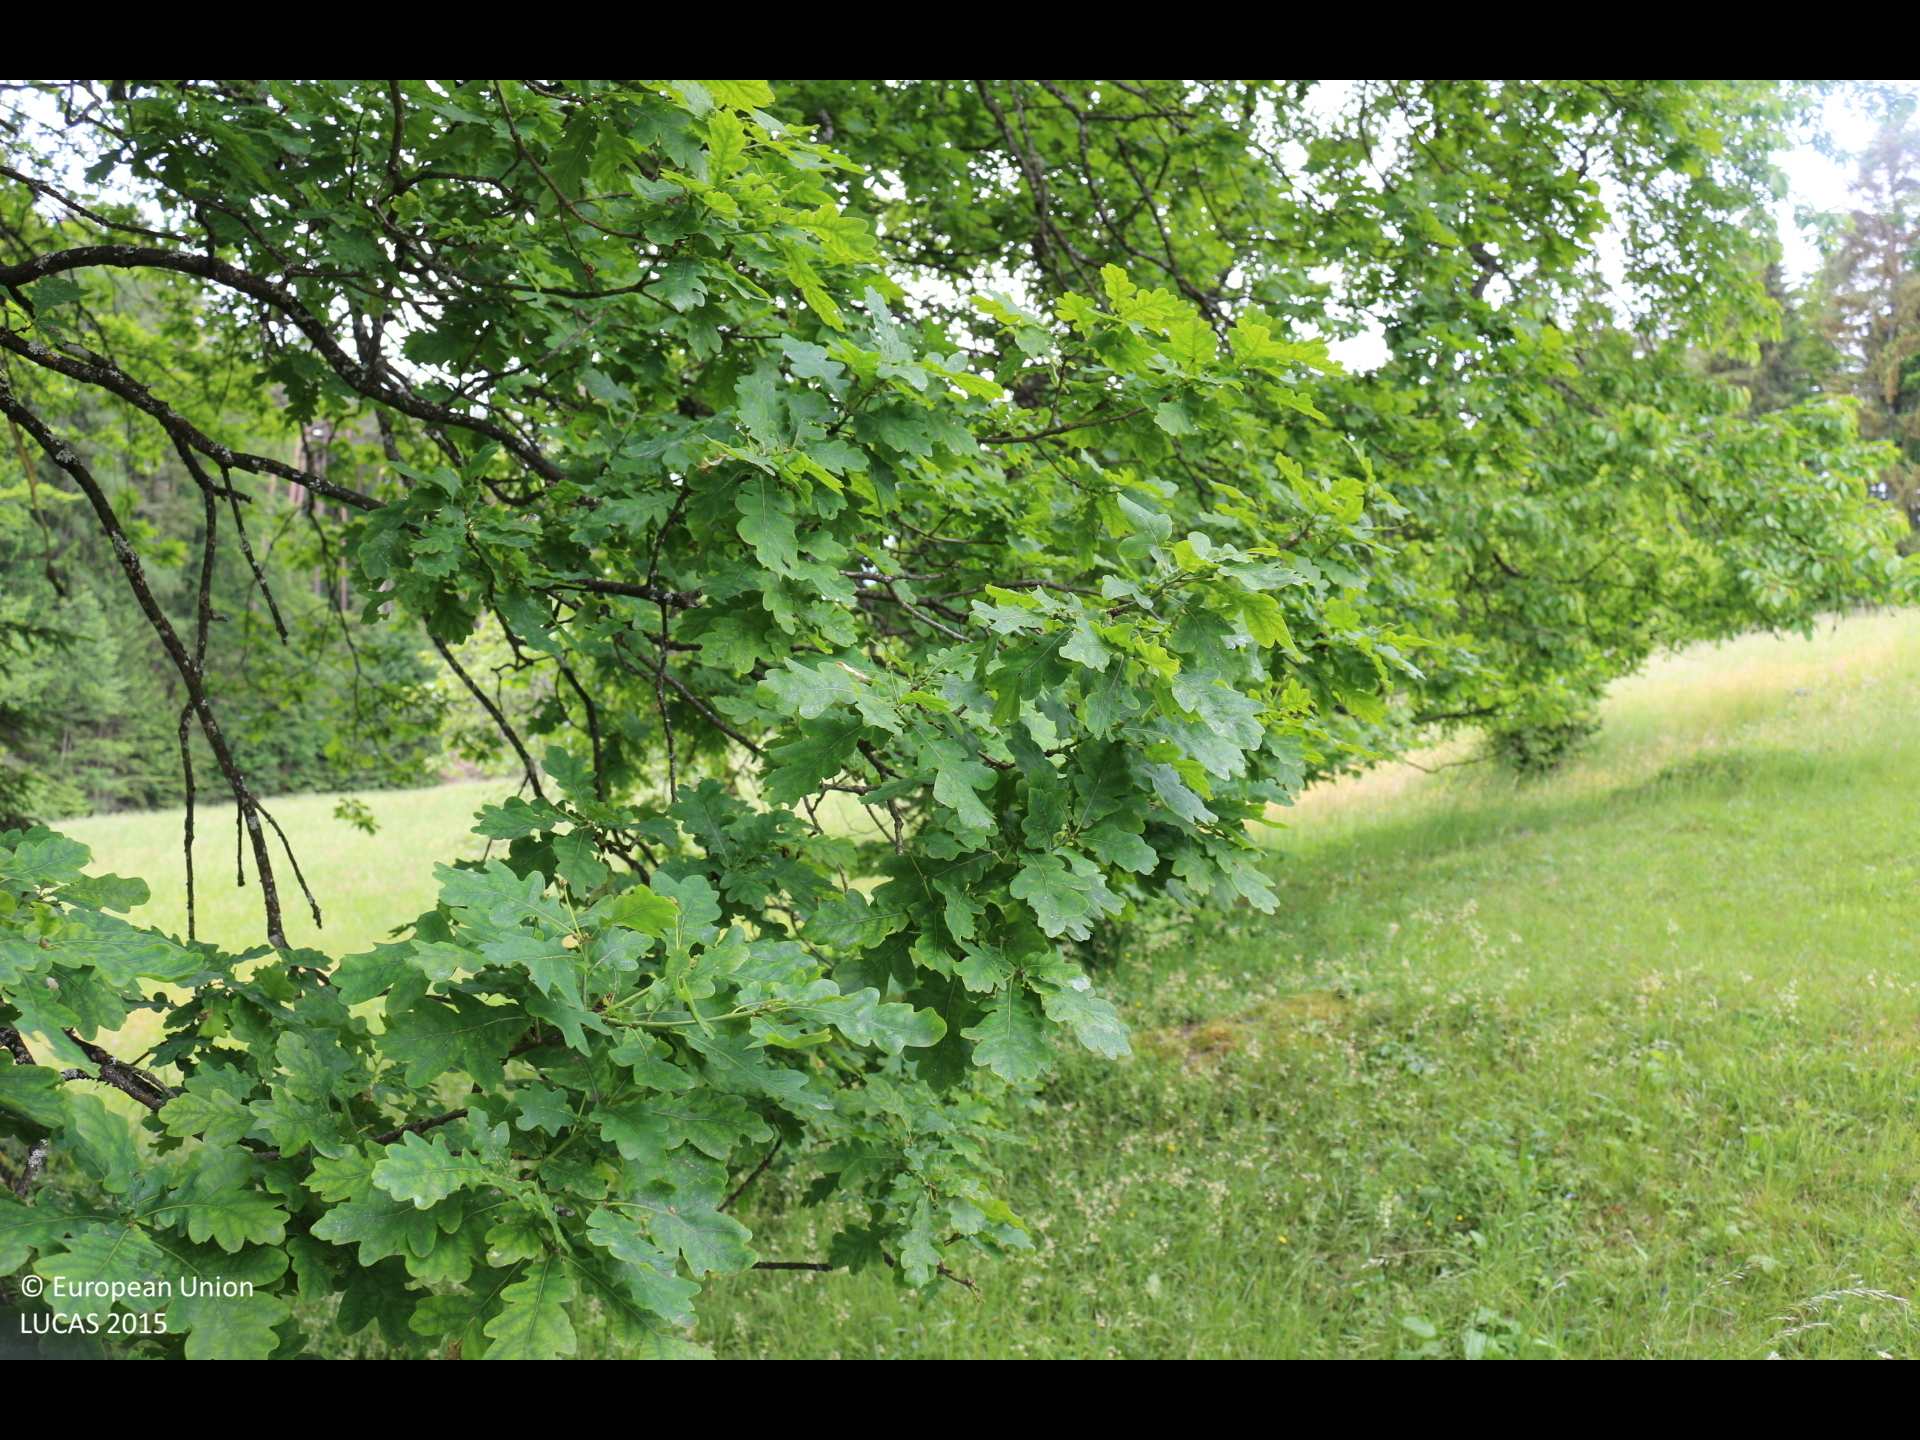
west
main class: Woodland
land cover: Broadleaved woodland
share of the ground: 50 - 75 %
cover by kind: broadleaved forest trees 70 %, herbaceous plants 30 %
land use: Agriculture (excluding fallow land and kitchen gardens)
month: May
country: AT
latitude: 46.6508
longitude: 14.1133
